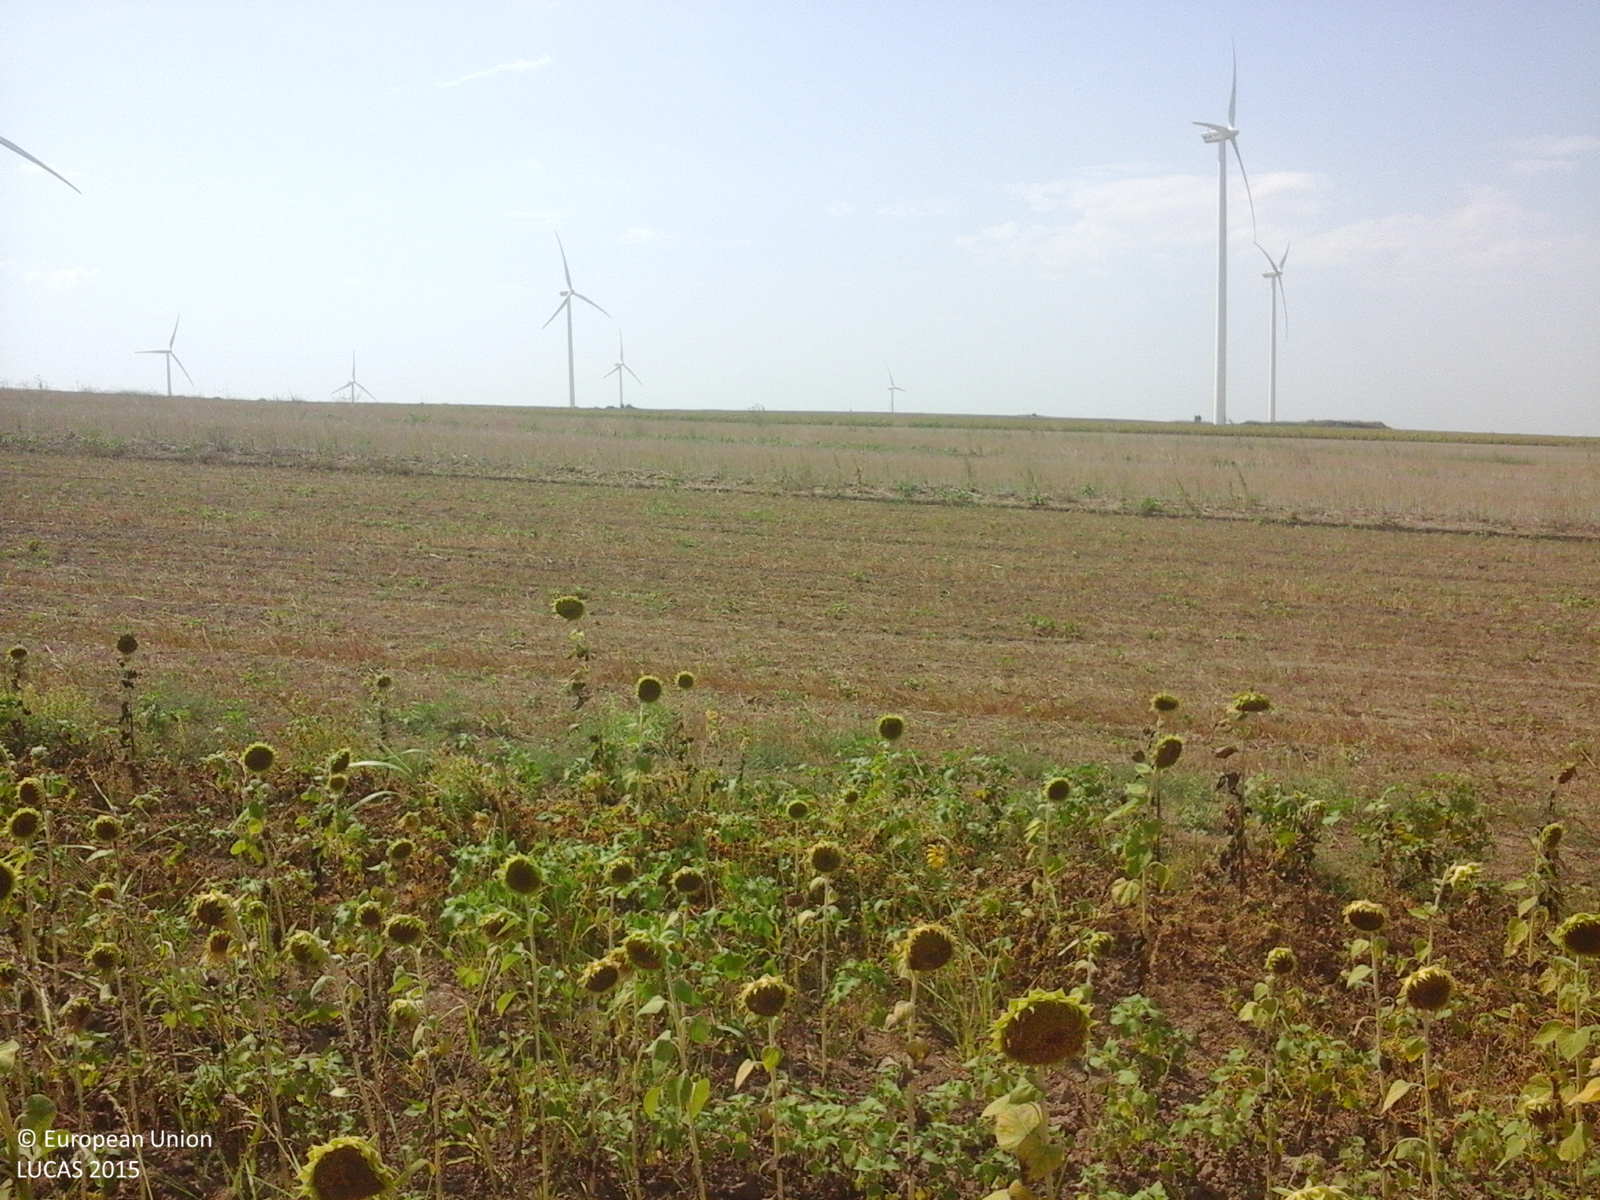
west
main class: Cropland
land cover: Sunflower
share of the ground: > 75 %
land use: Agriculture (excluding fallow land and kitchen gardens)
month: August
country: RO
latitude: 44.3153
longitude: 28.1775
